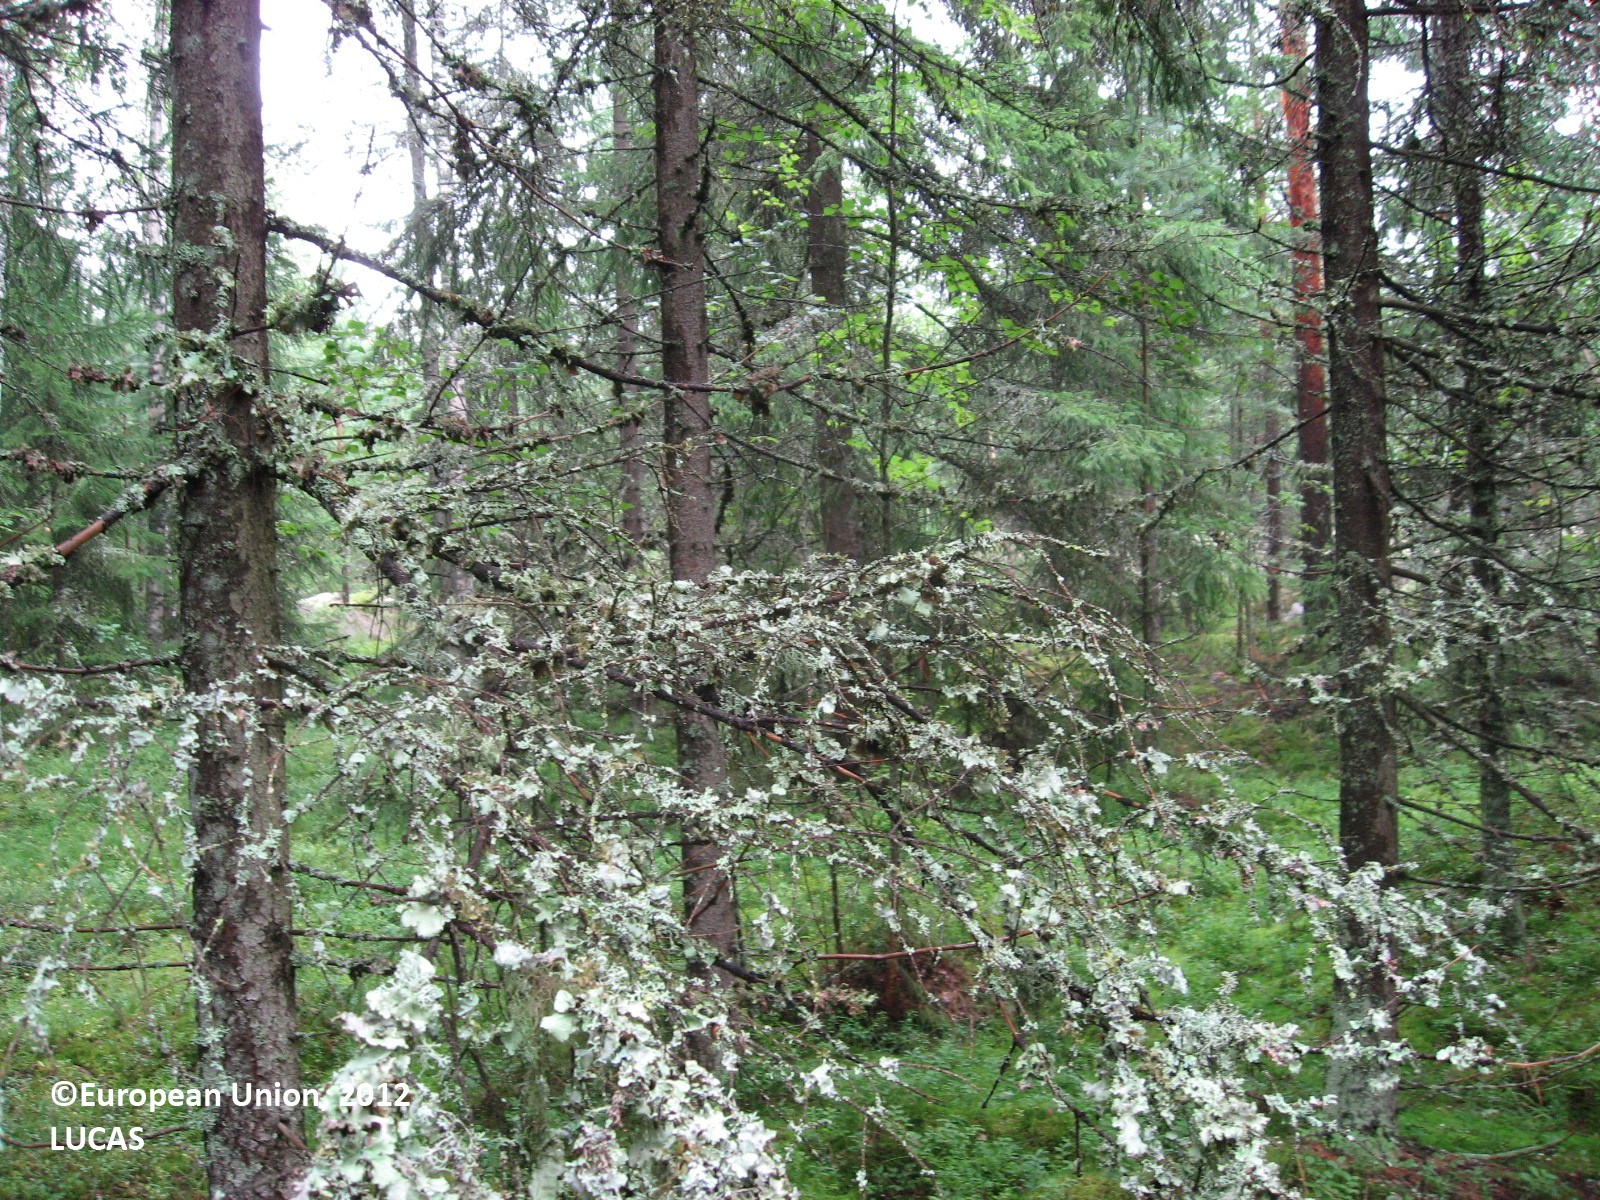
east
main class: Woodland
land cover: Spruce dominated coniferous woodland
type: boreal forest
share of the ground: > 75 %
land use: Forestry
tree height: > 5 m
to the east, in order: Spruce dominated coniferous woodland; Ditches and canals; Spruce dominated coniferous woodland; Grassland with sparse tree/shrub cover
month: August
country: FI
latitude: 60.5317
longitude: 25.4911
